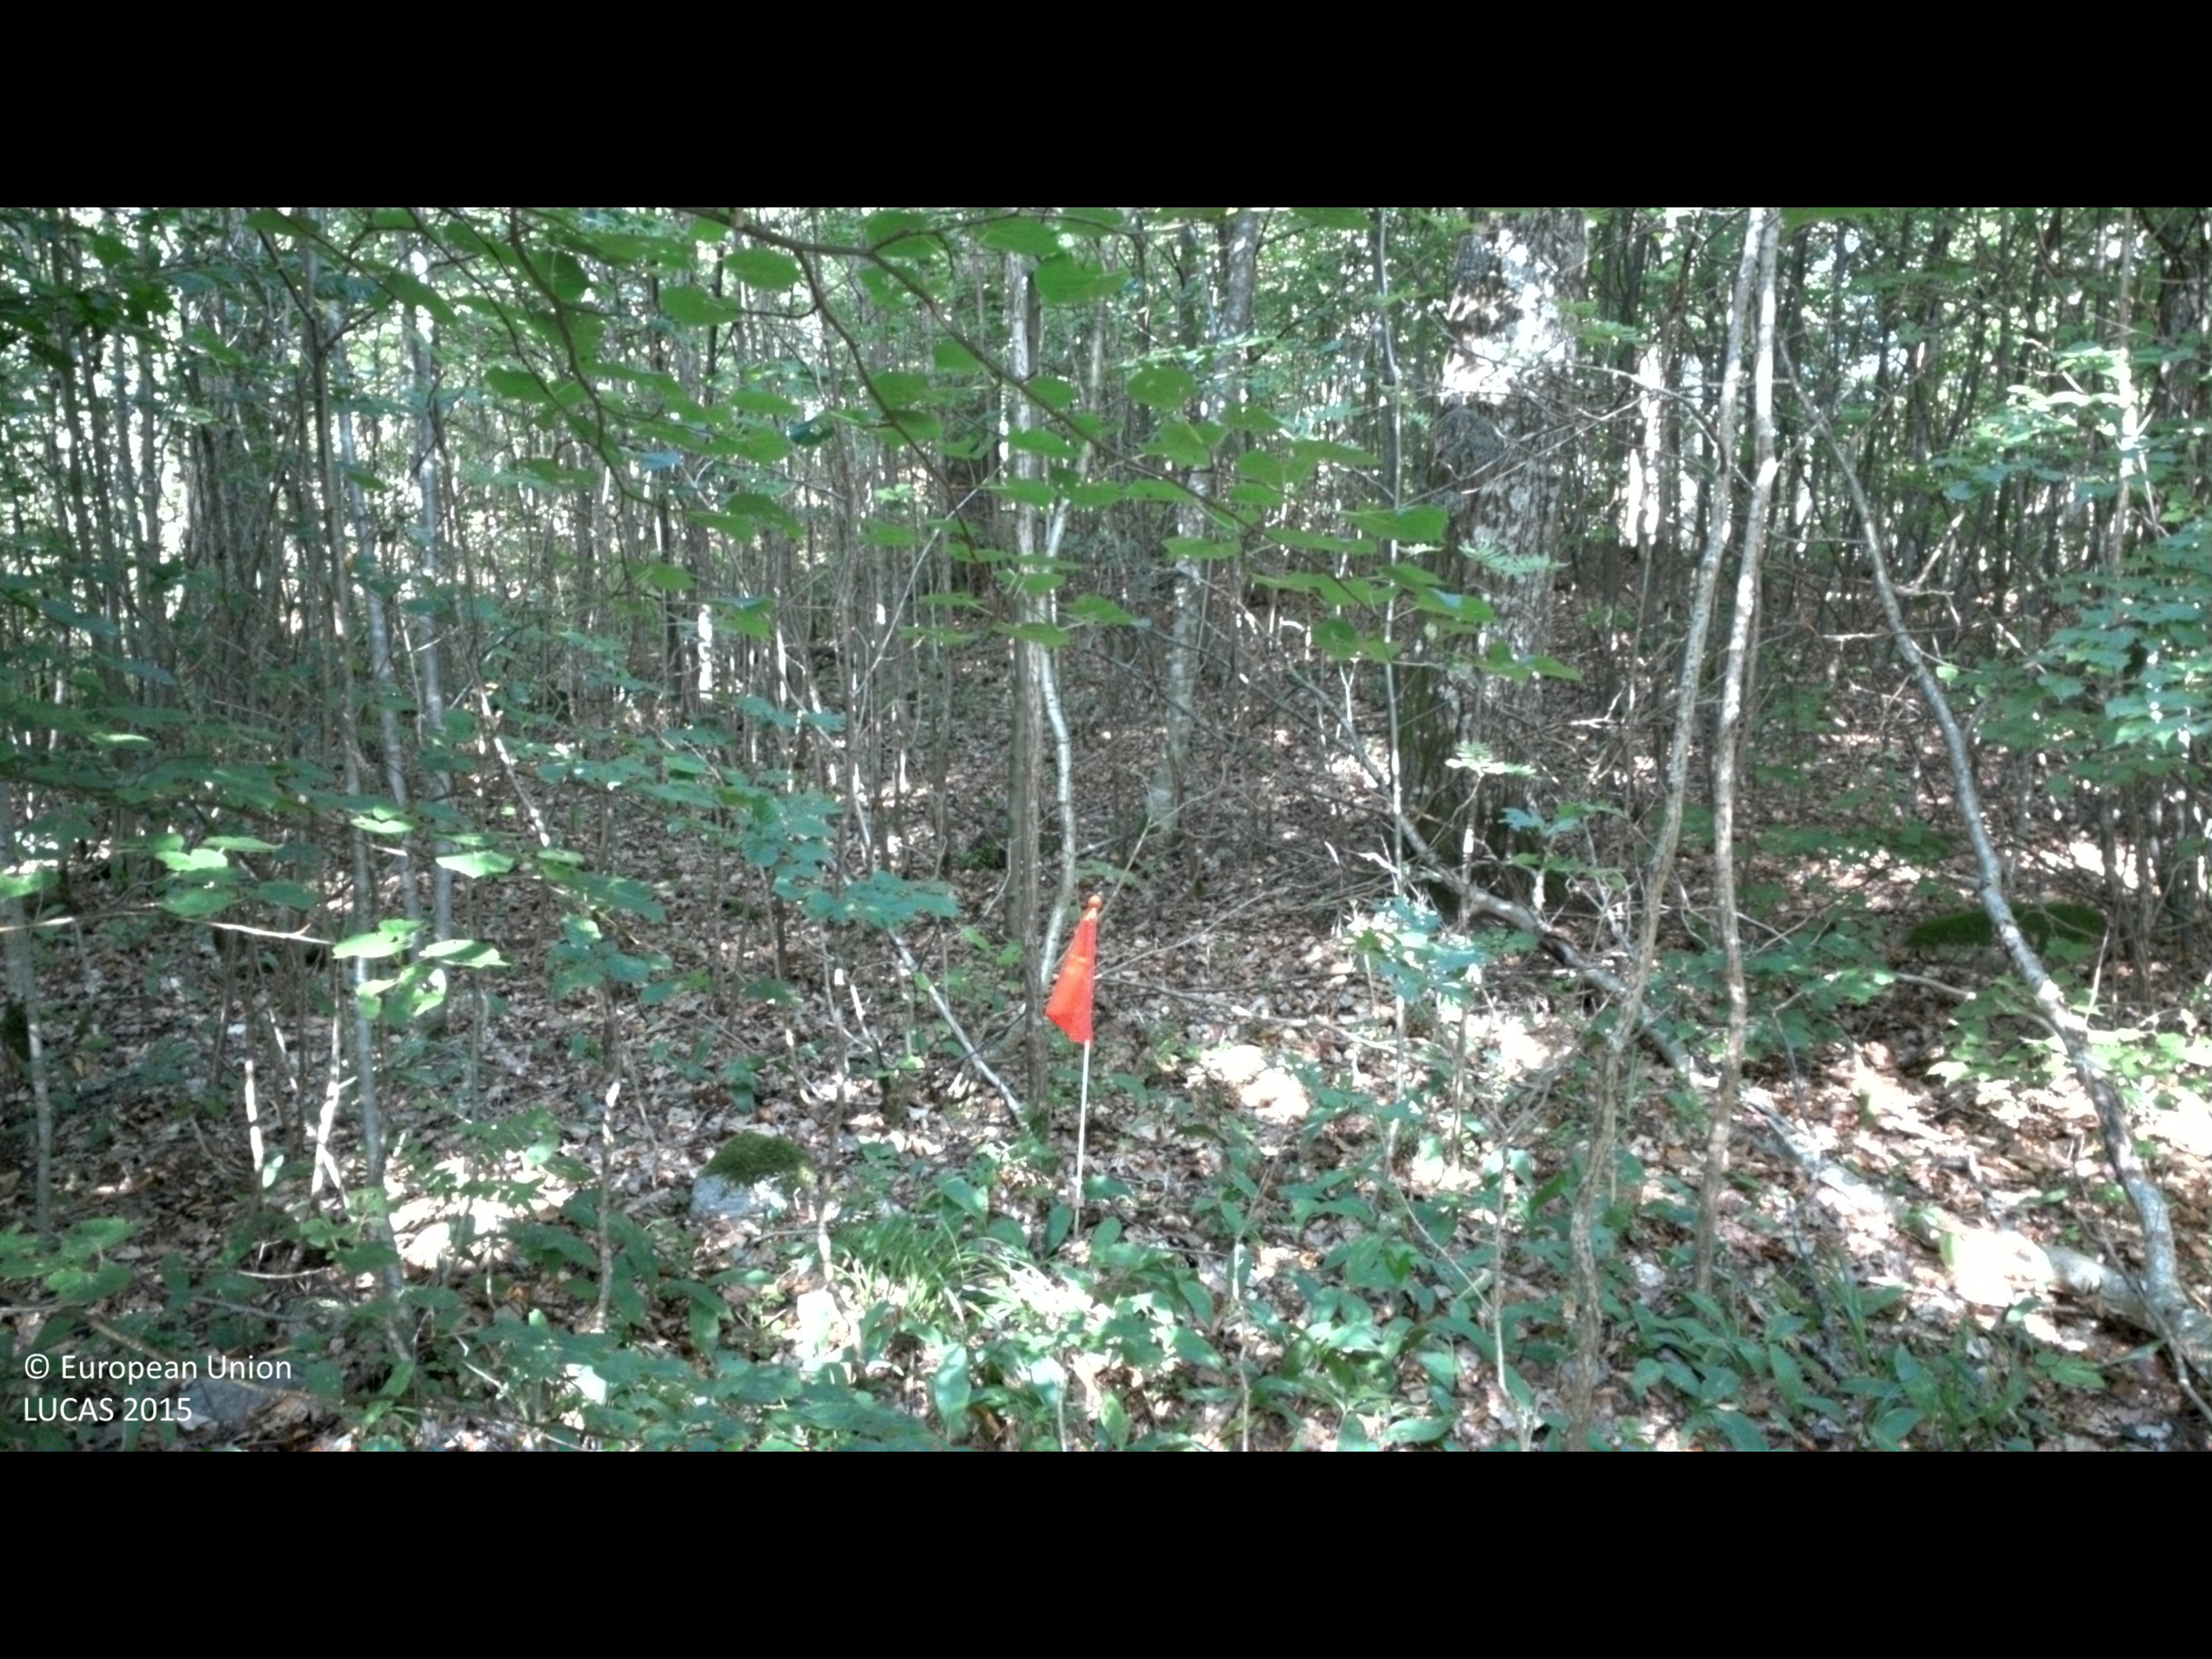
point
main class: Woodland
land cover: Broadleaved woodland
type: hemiboreal forest and nemoral coniferous forest and mixed broadleaved-coniferous forest
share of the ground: > 75 %
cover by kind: broadleaved forest trees 85 %, shrubs 15 %
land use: Amenities, museums, leisure
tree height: > 5 m
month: August
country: SE
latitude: 56.6068
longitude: 14.1513
